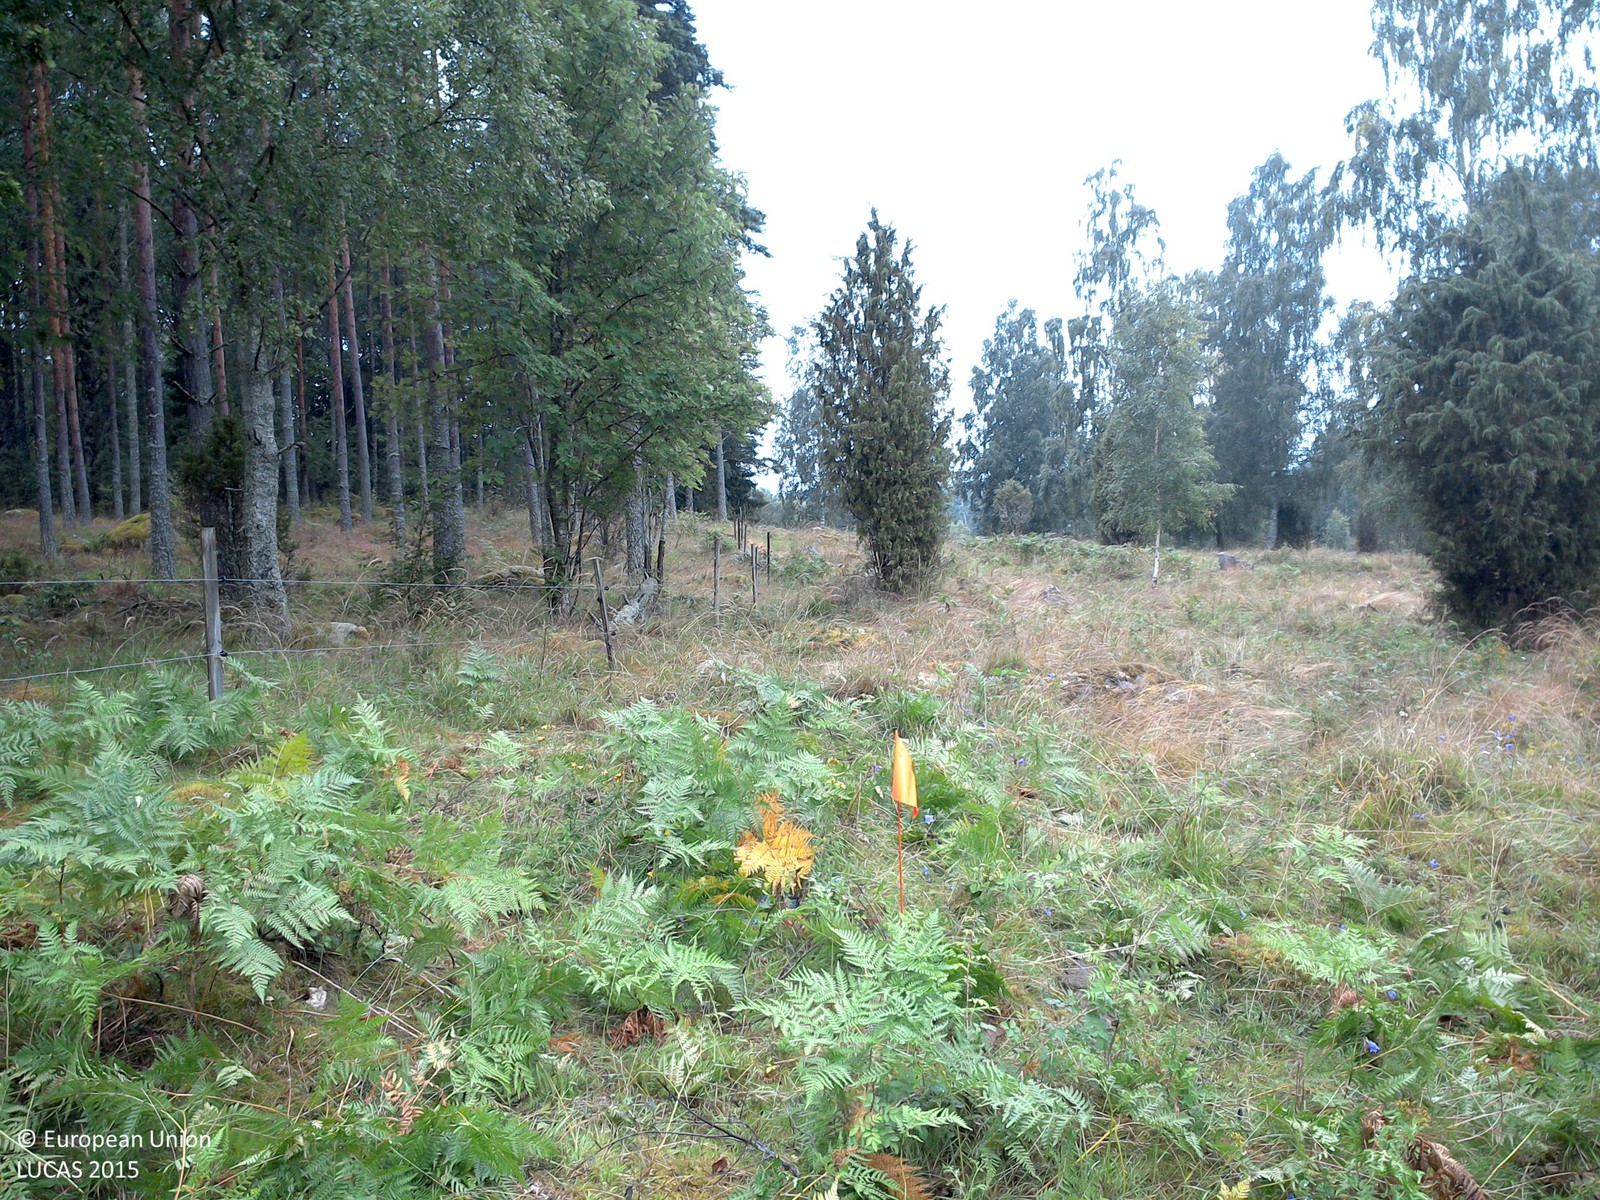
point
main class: Grassland
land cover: Grassland with sparse tree/shrub cover
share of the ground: > 75 %
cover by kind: herbaceous plants 90 %, broadleaved forest trees 5 %, shrubs 5 %
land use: Agriculture (excluding fallow land and kitchen gardens)
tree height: > 5 m
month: August
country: SE
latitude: 58.2141
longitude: 15.5268
